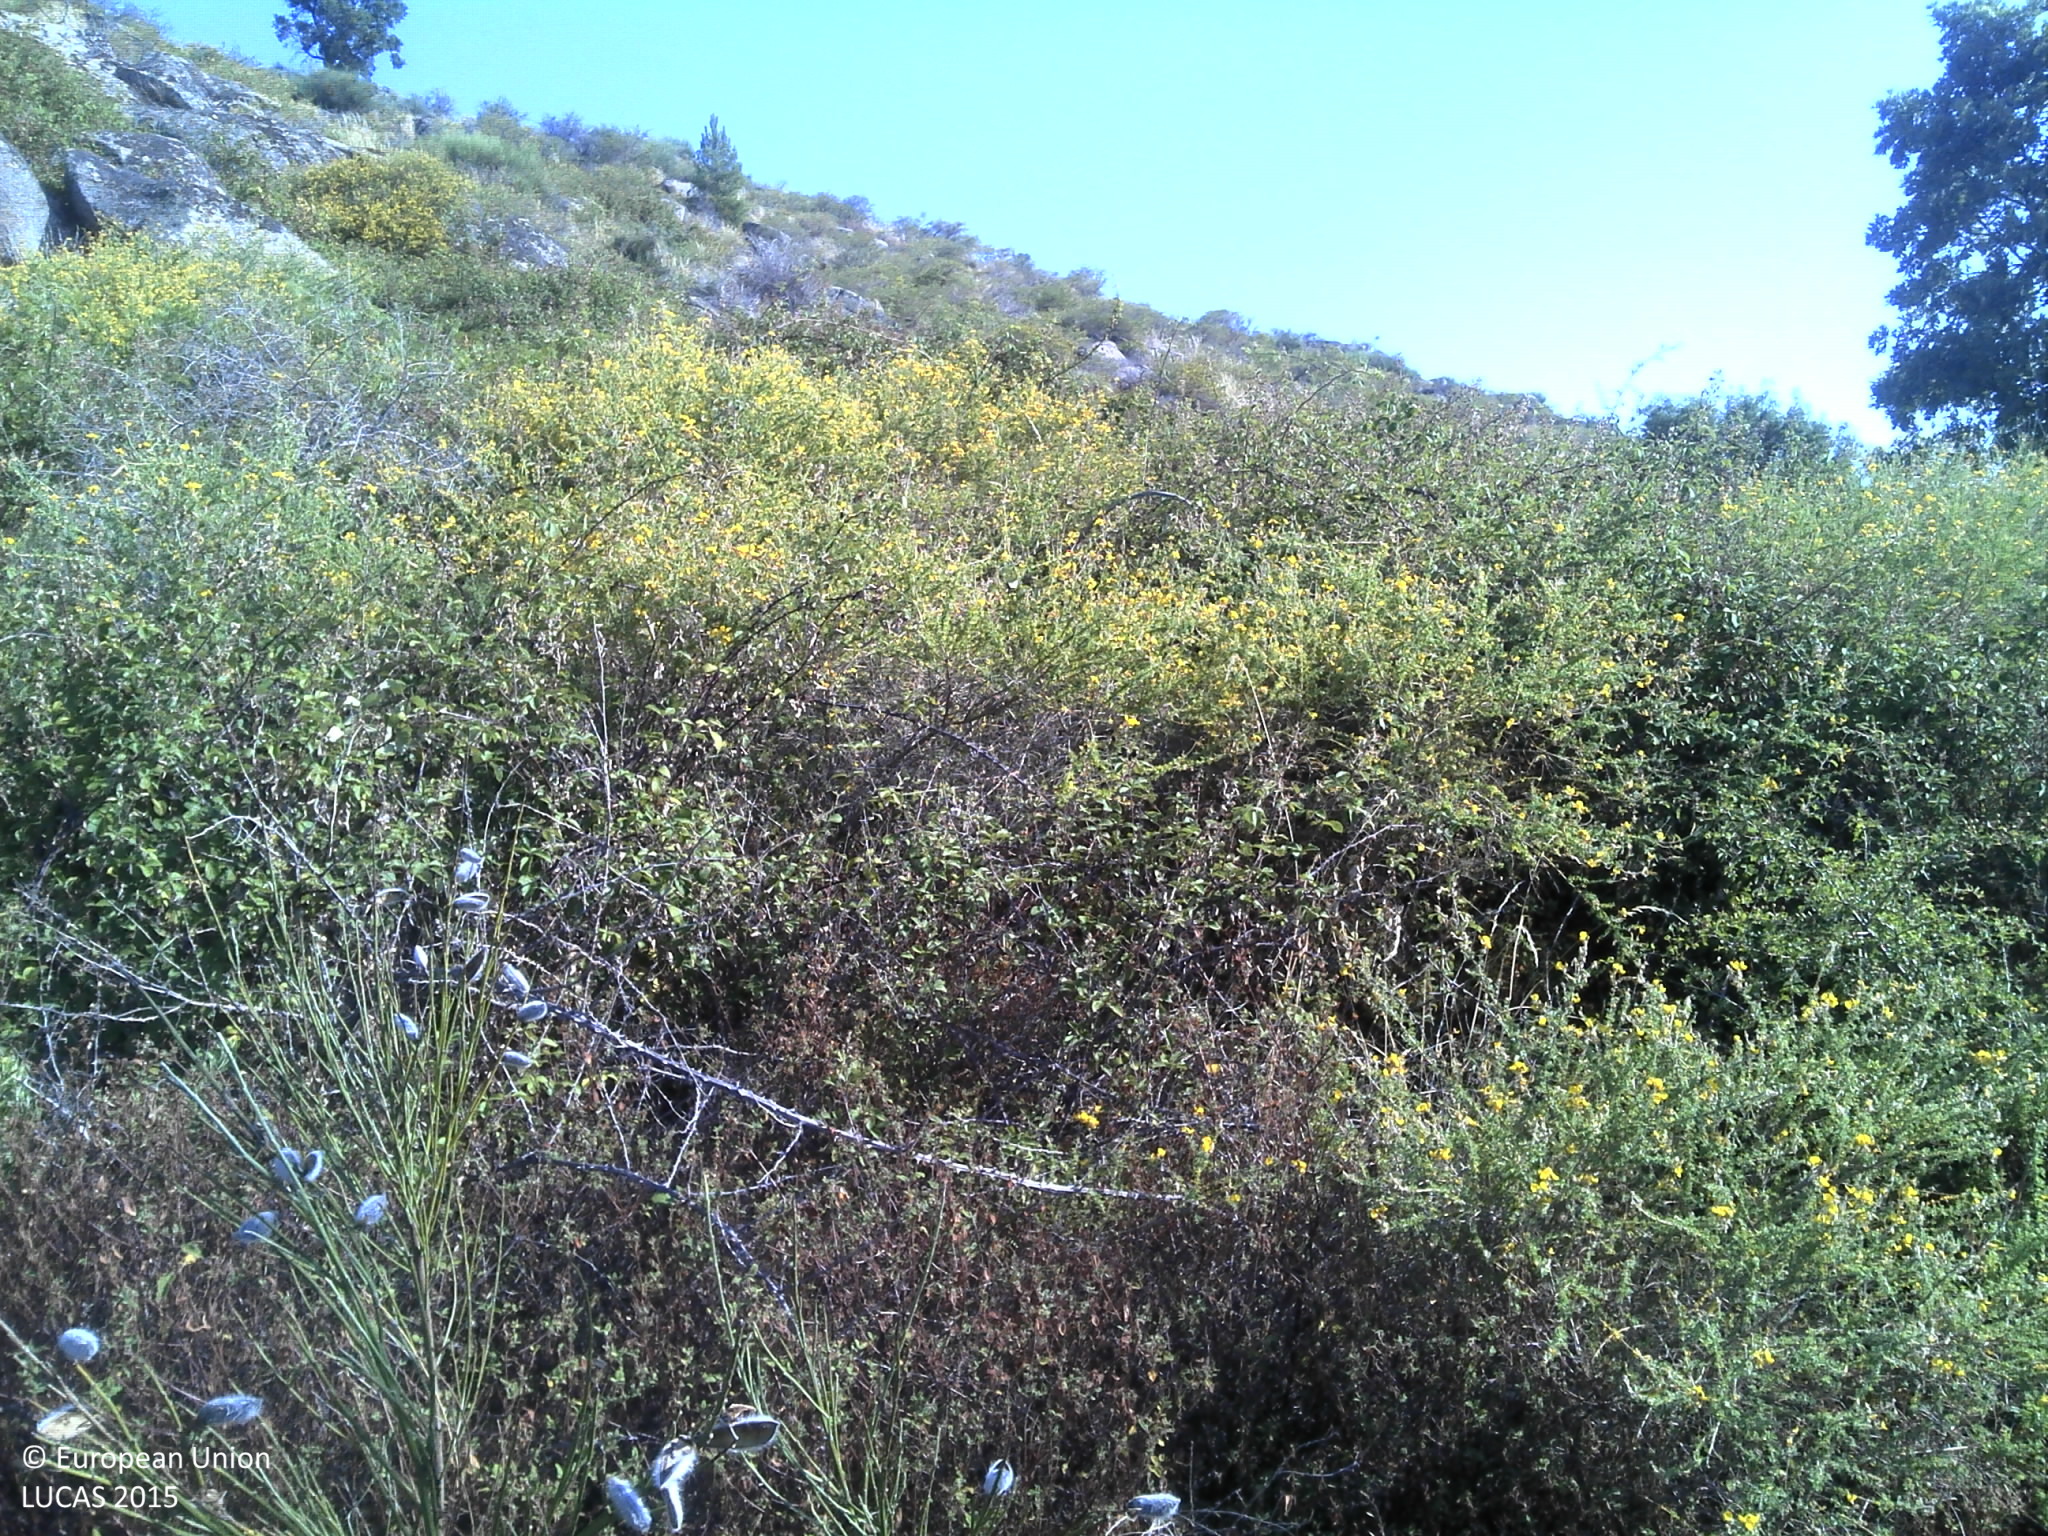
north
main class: Shrubland
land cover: Shrubland with sparse tree cover
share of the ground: 50 - 75 %
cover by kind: shrubs 70 %, herbaceous plants 15 %, coniferous forest trees 5 %, unconsolidated bare surface 5 %
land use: Semi-natural and natural areas not in use
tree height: < 5 m
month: June
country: PT
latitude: 40.0849
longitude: -7.1836
